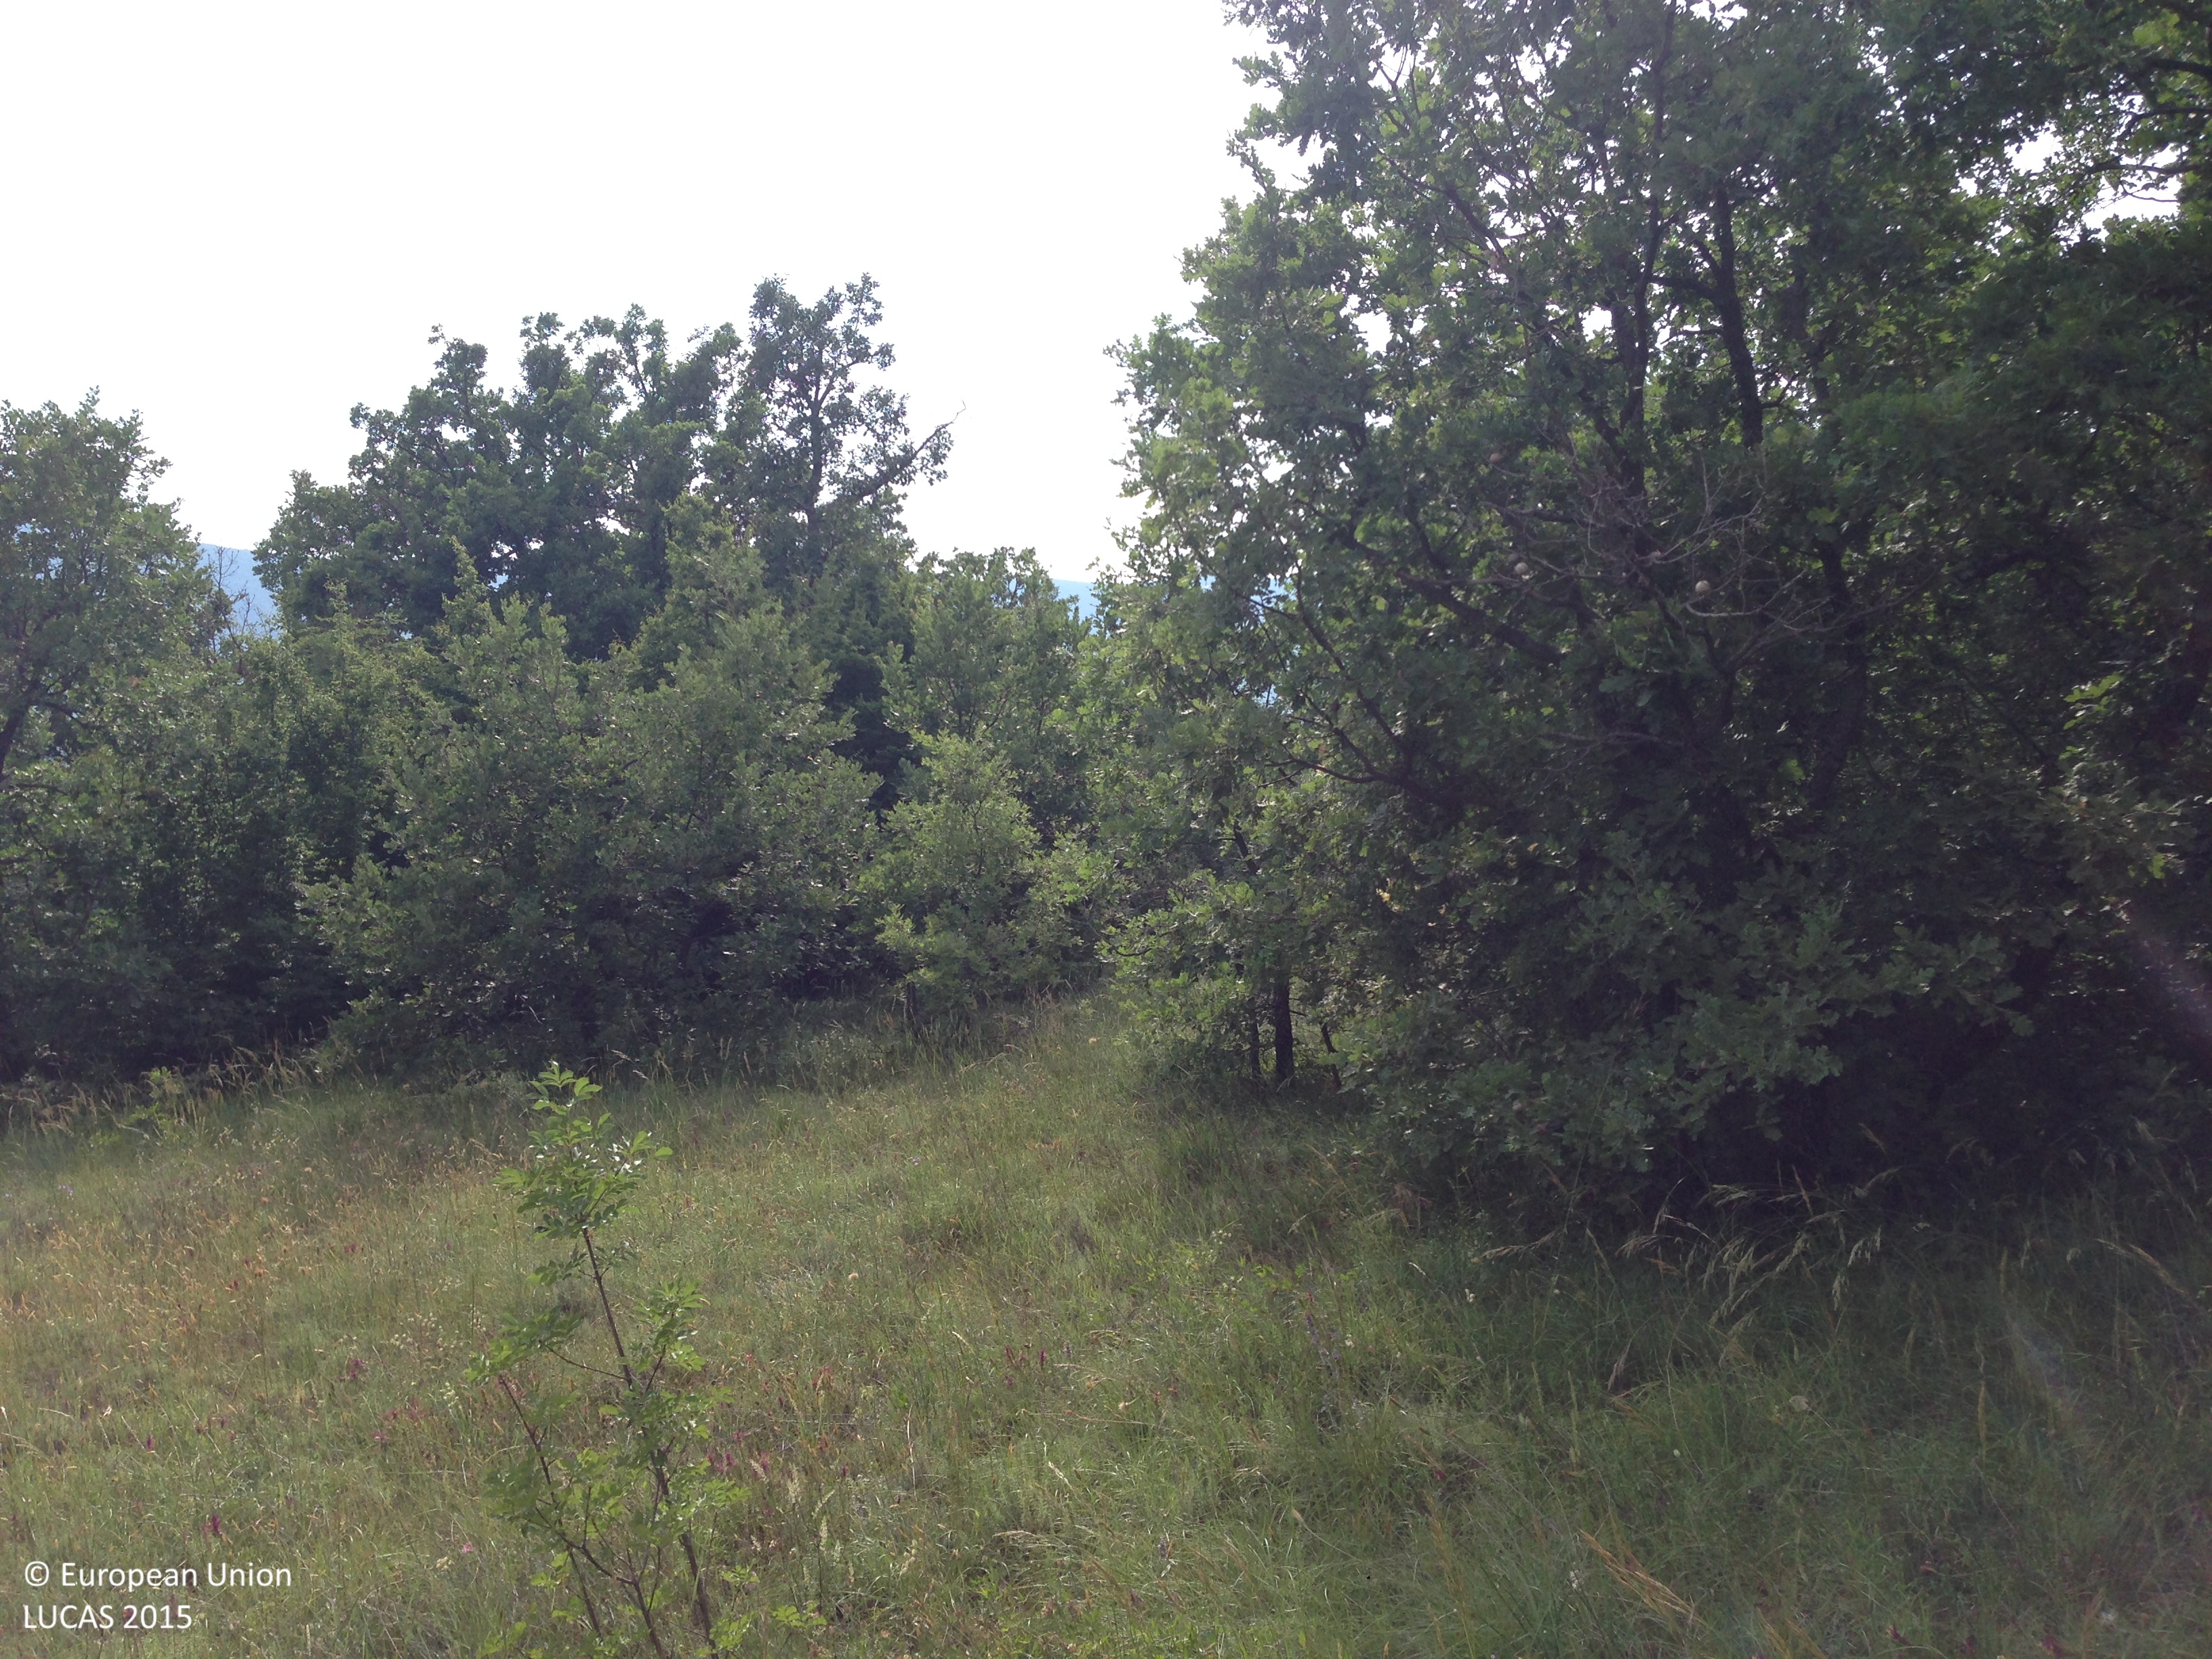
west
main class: Woodland
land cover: Broadleaved woodland
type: thermophilous deciduous forest
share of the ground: 25 - 50 %
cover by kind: herbaceous plants 40 %, broadleaved forest trees 35 %, shrubs 10 %, unconsolidated bare surface 10 %, consolidated bare surface 5 %
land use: Semi-natural and natural areas not in use
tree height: > 5 m
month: June
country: HR
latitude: 43.7377
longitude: 16.3860
